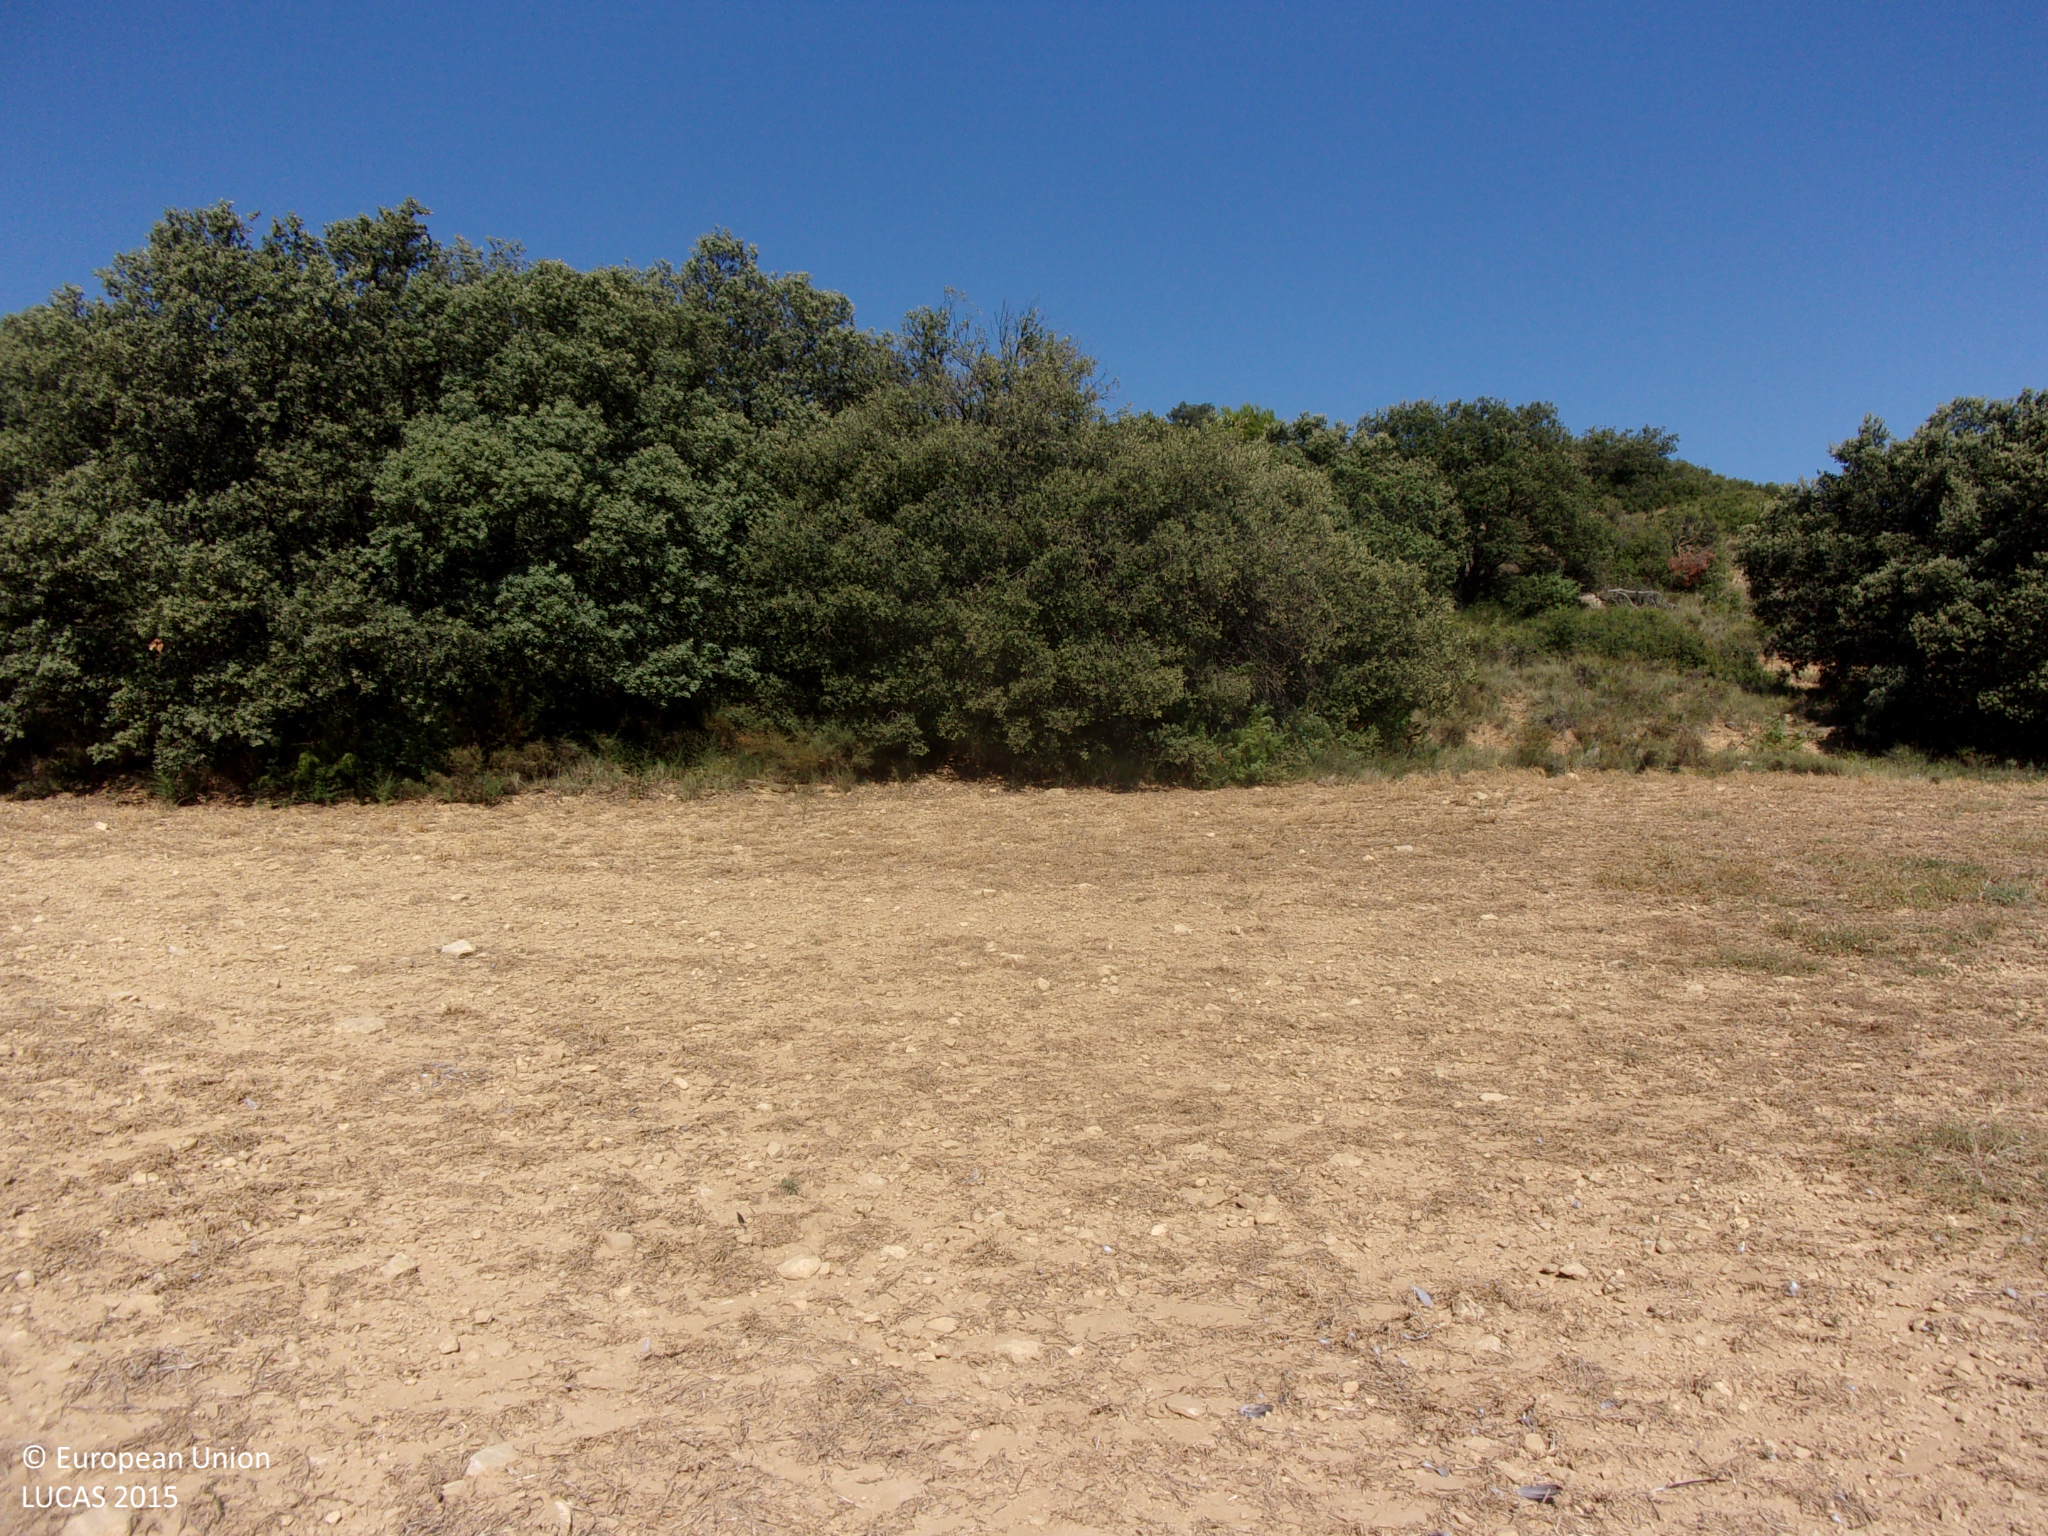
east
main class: Grassland
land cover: Spontaneously vegetated surfaces
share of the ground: 50 - 75 %
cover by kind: herbaceous plants 75 %, unconsolidated bare surface 25 %
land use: Fallow land
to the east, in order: Spontaneously vegetated surfaces; Lines of trees; Ditches and canals; Broadleaved woodland; Tracks; Broadleaved woodland
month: August
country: ES
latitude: 42.3349
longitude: -1.0861
